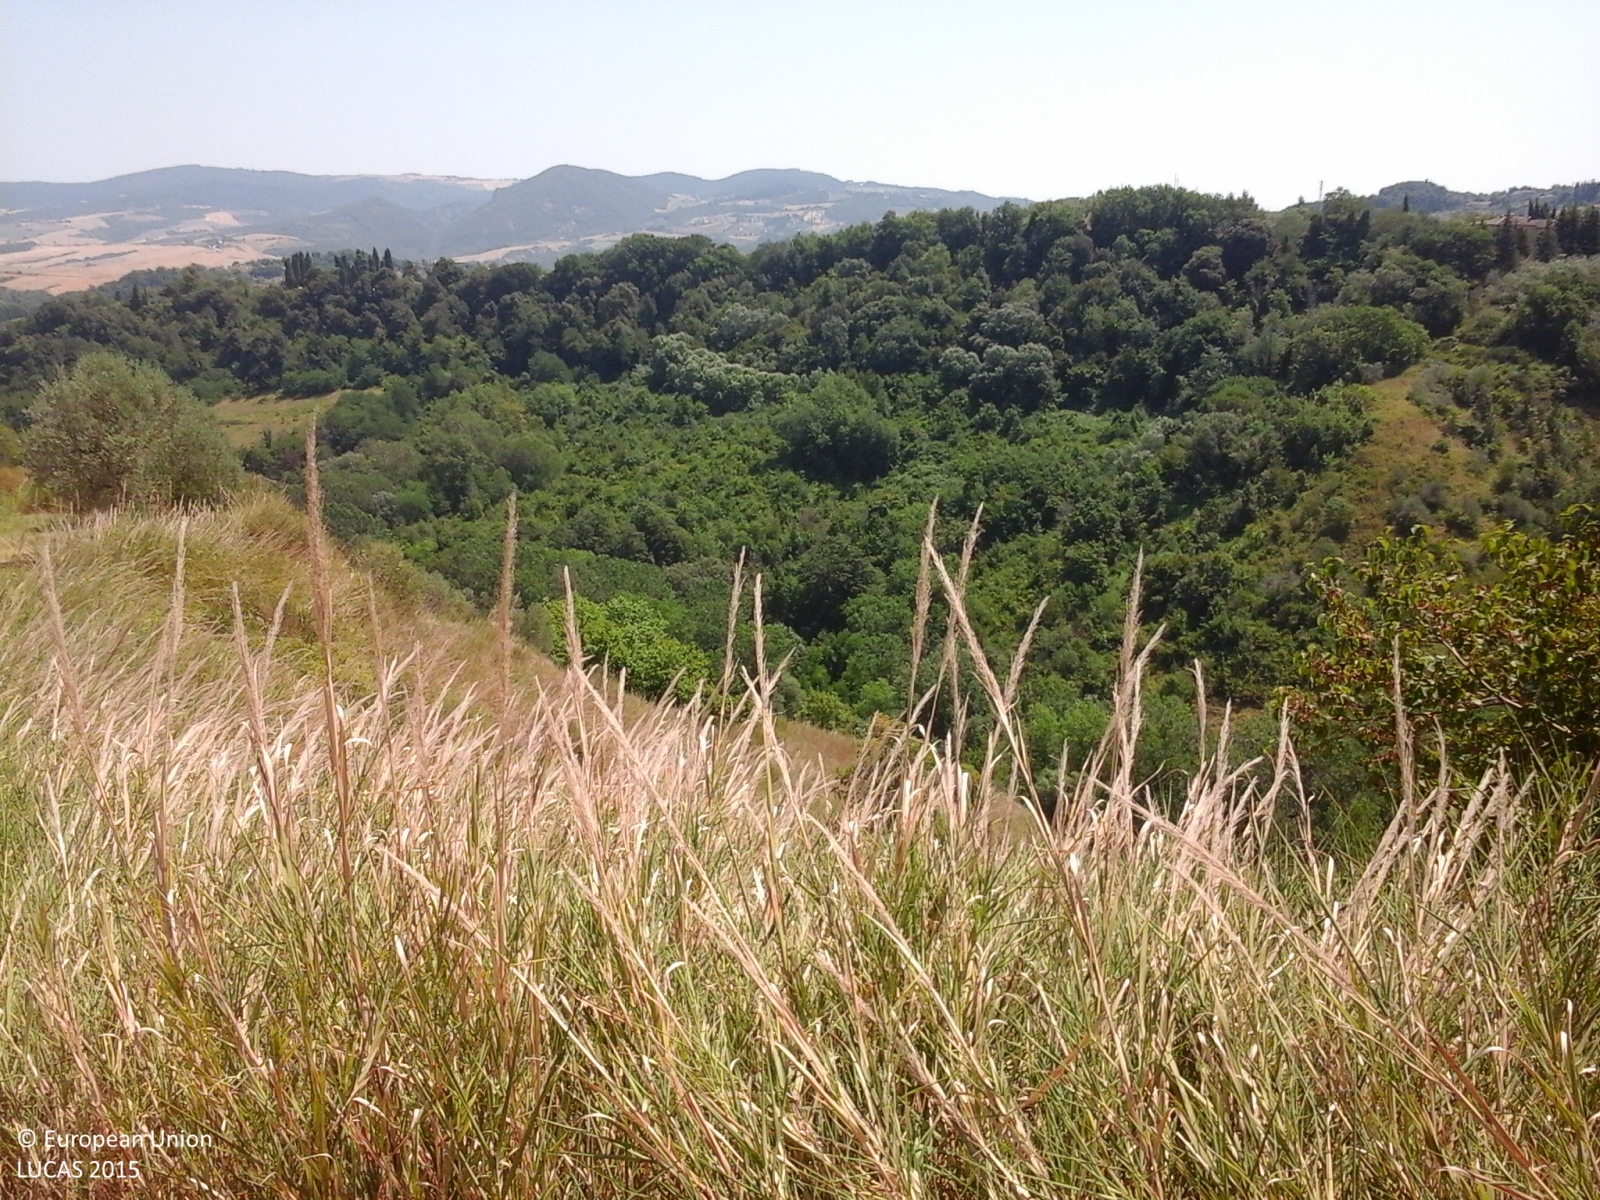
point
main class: Grassland
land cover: Grassland with sparse tree/shrub cover
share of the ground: > 75 %
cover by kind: herbaceous plants 90 %, broadleaved forest trees 5 %, shrubs 5 %
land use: Semi-natural and natural areas not in use
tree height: < 5 m
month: July
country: IT
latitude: 43.4269
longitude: 10.8499
